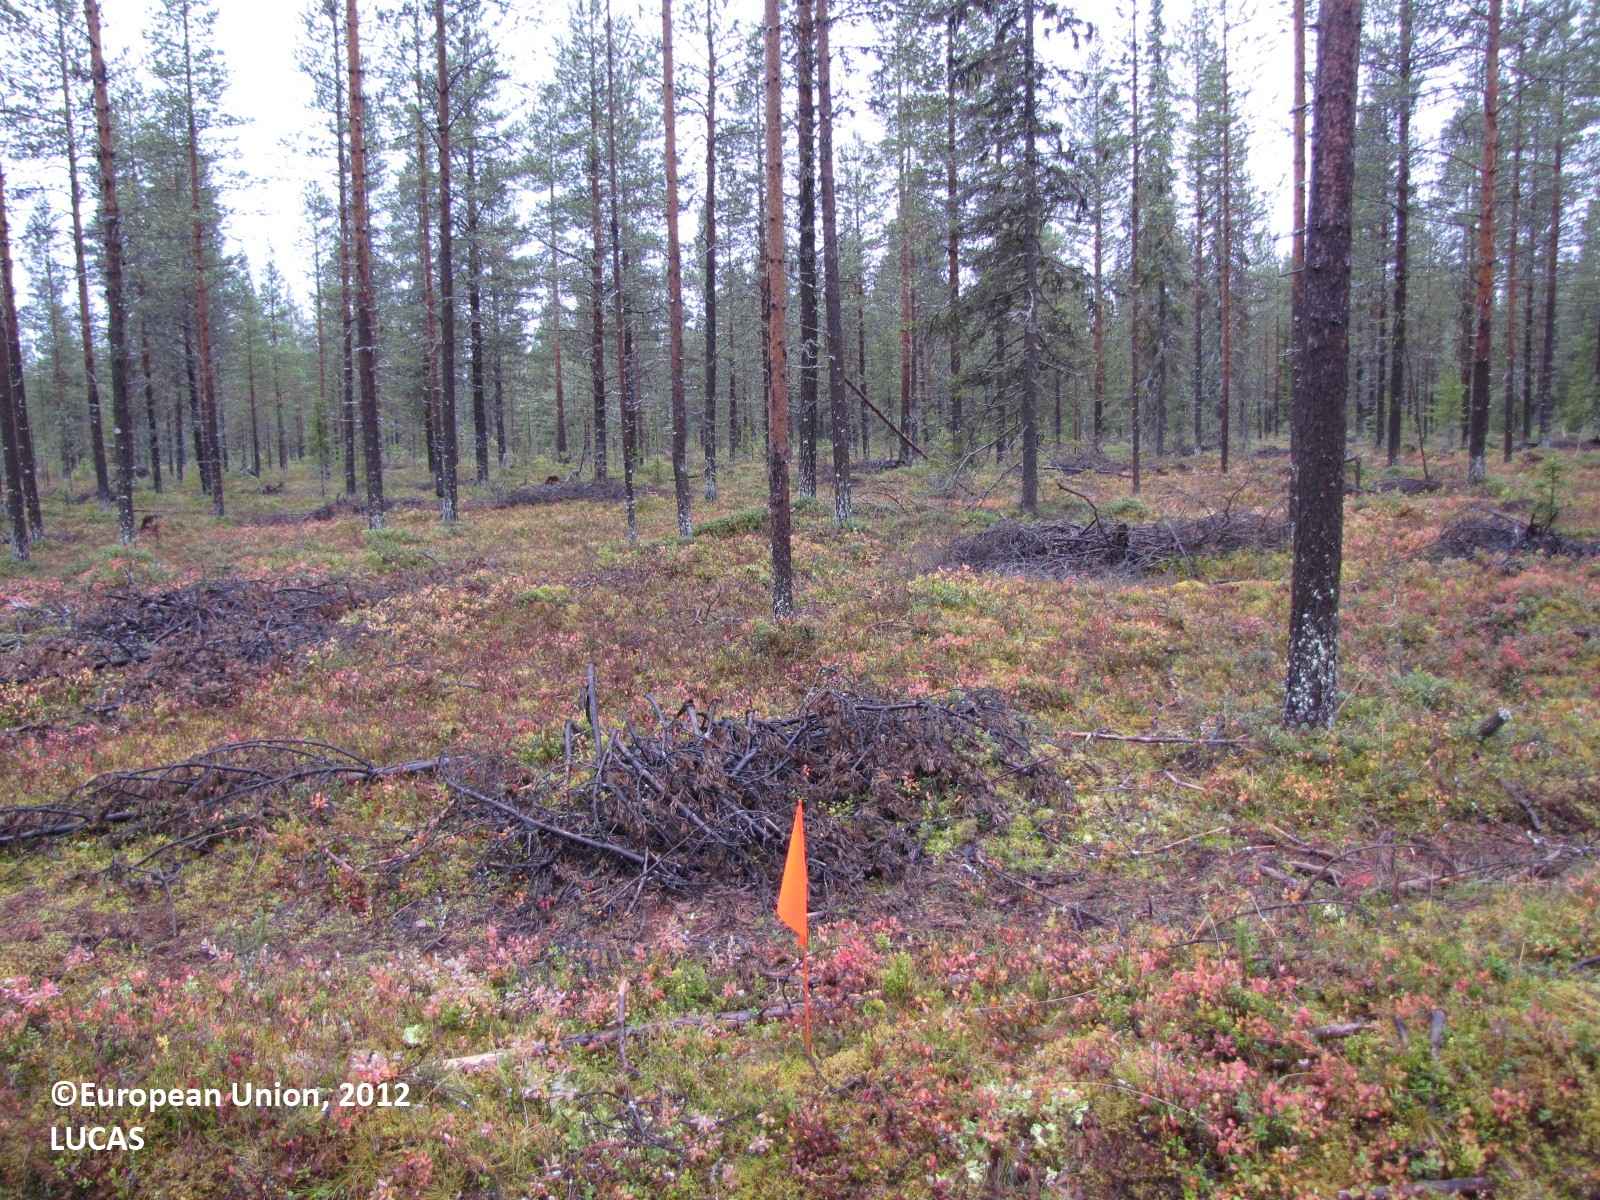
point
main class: Woodland
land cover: Pine dominated coniferous woodland
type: boreal forest
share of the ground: 25 - 50 %
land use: Forestry
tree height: > 5 m
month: September
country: FI
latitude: 67.6440
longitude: 23.5614
